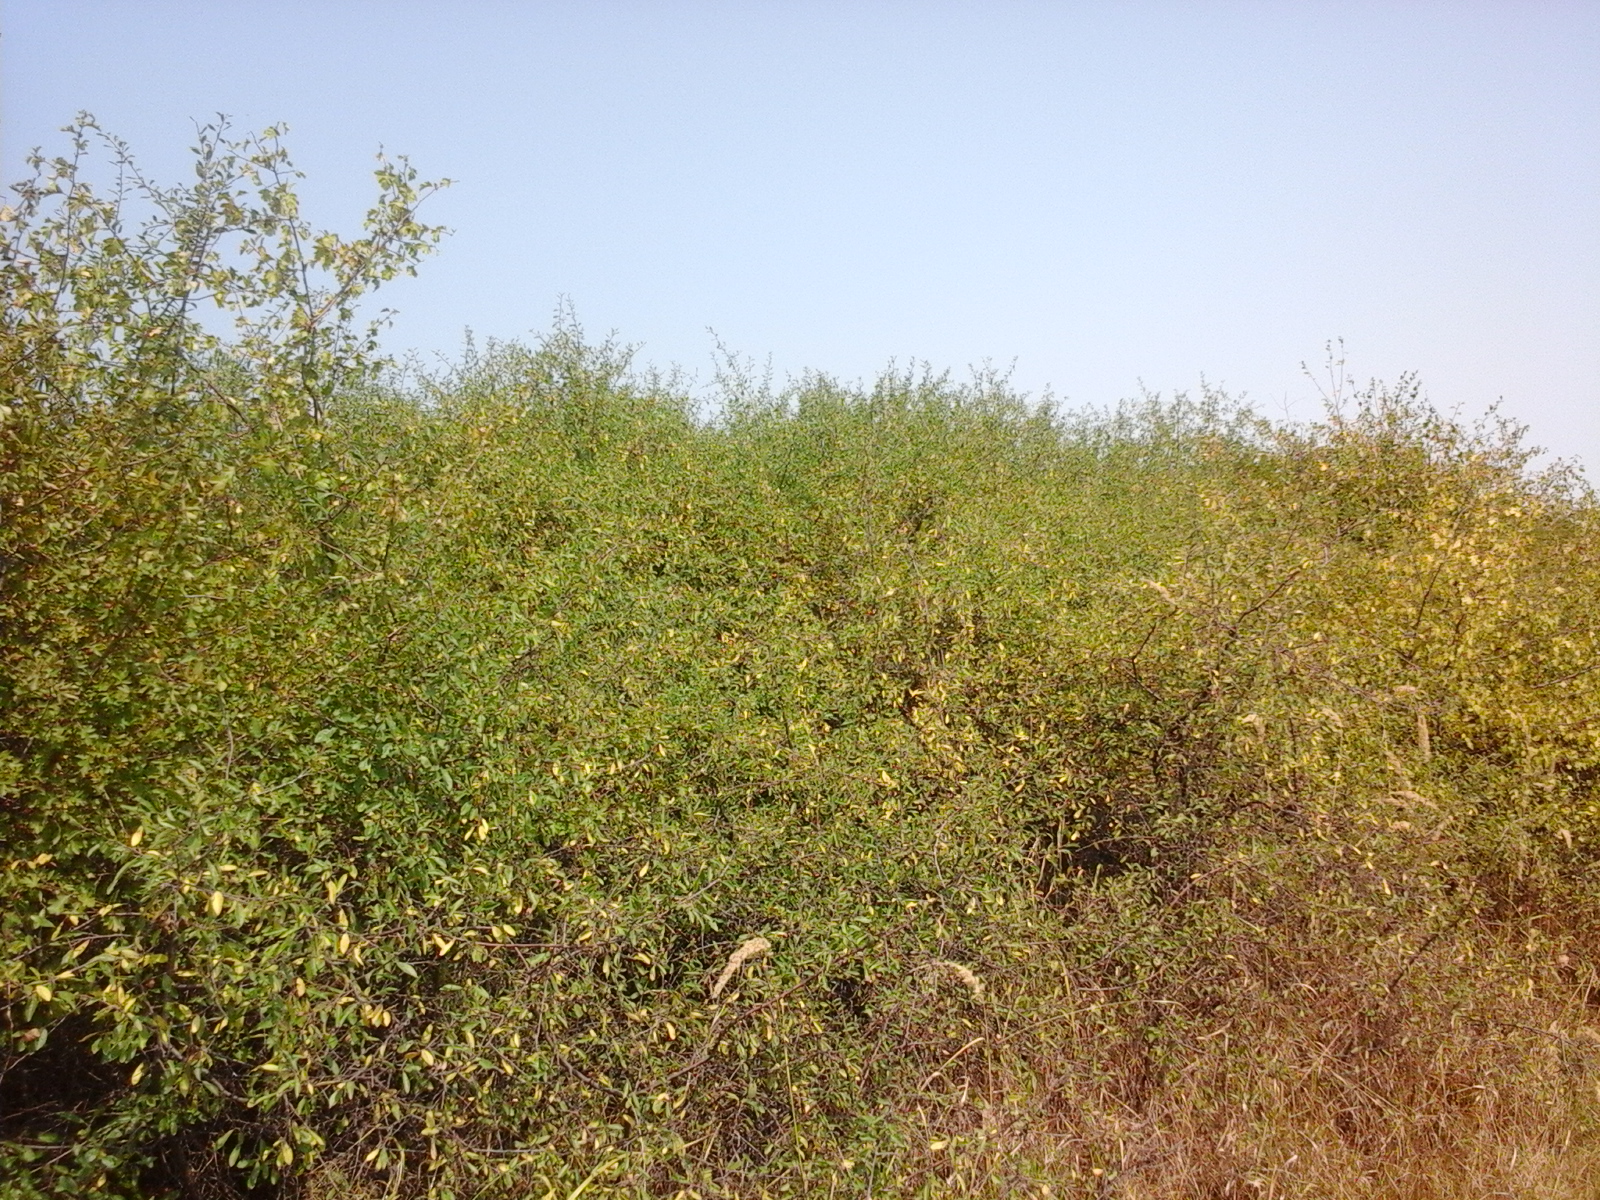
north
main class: Shrubland
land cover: Shrubland with sparse tree cover
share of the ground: > 75 %
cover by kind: shrubs 95 %, broadleaved forest trees 5 %
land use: Semi-natural and natural areas not in use
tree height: < 5 m
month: August
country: RO
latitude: 44.5042
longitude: 23.7805
